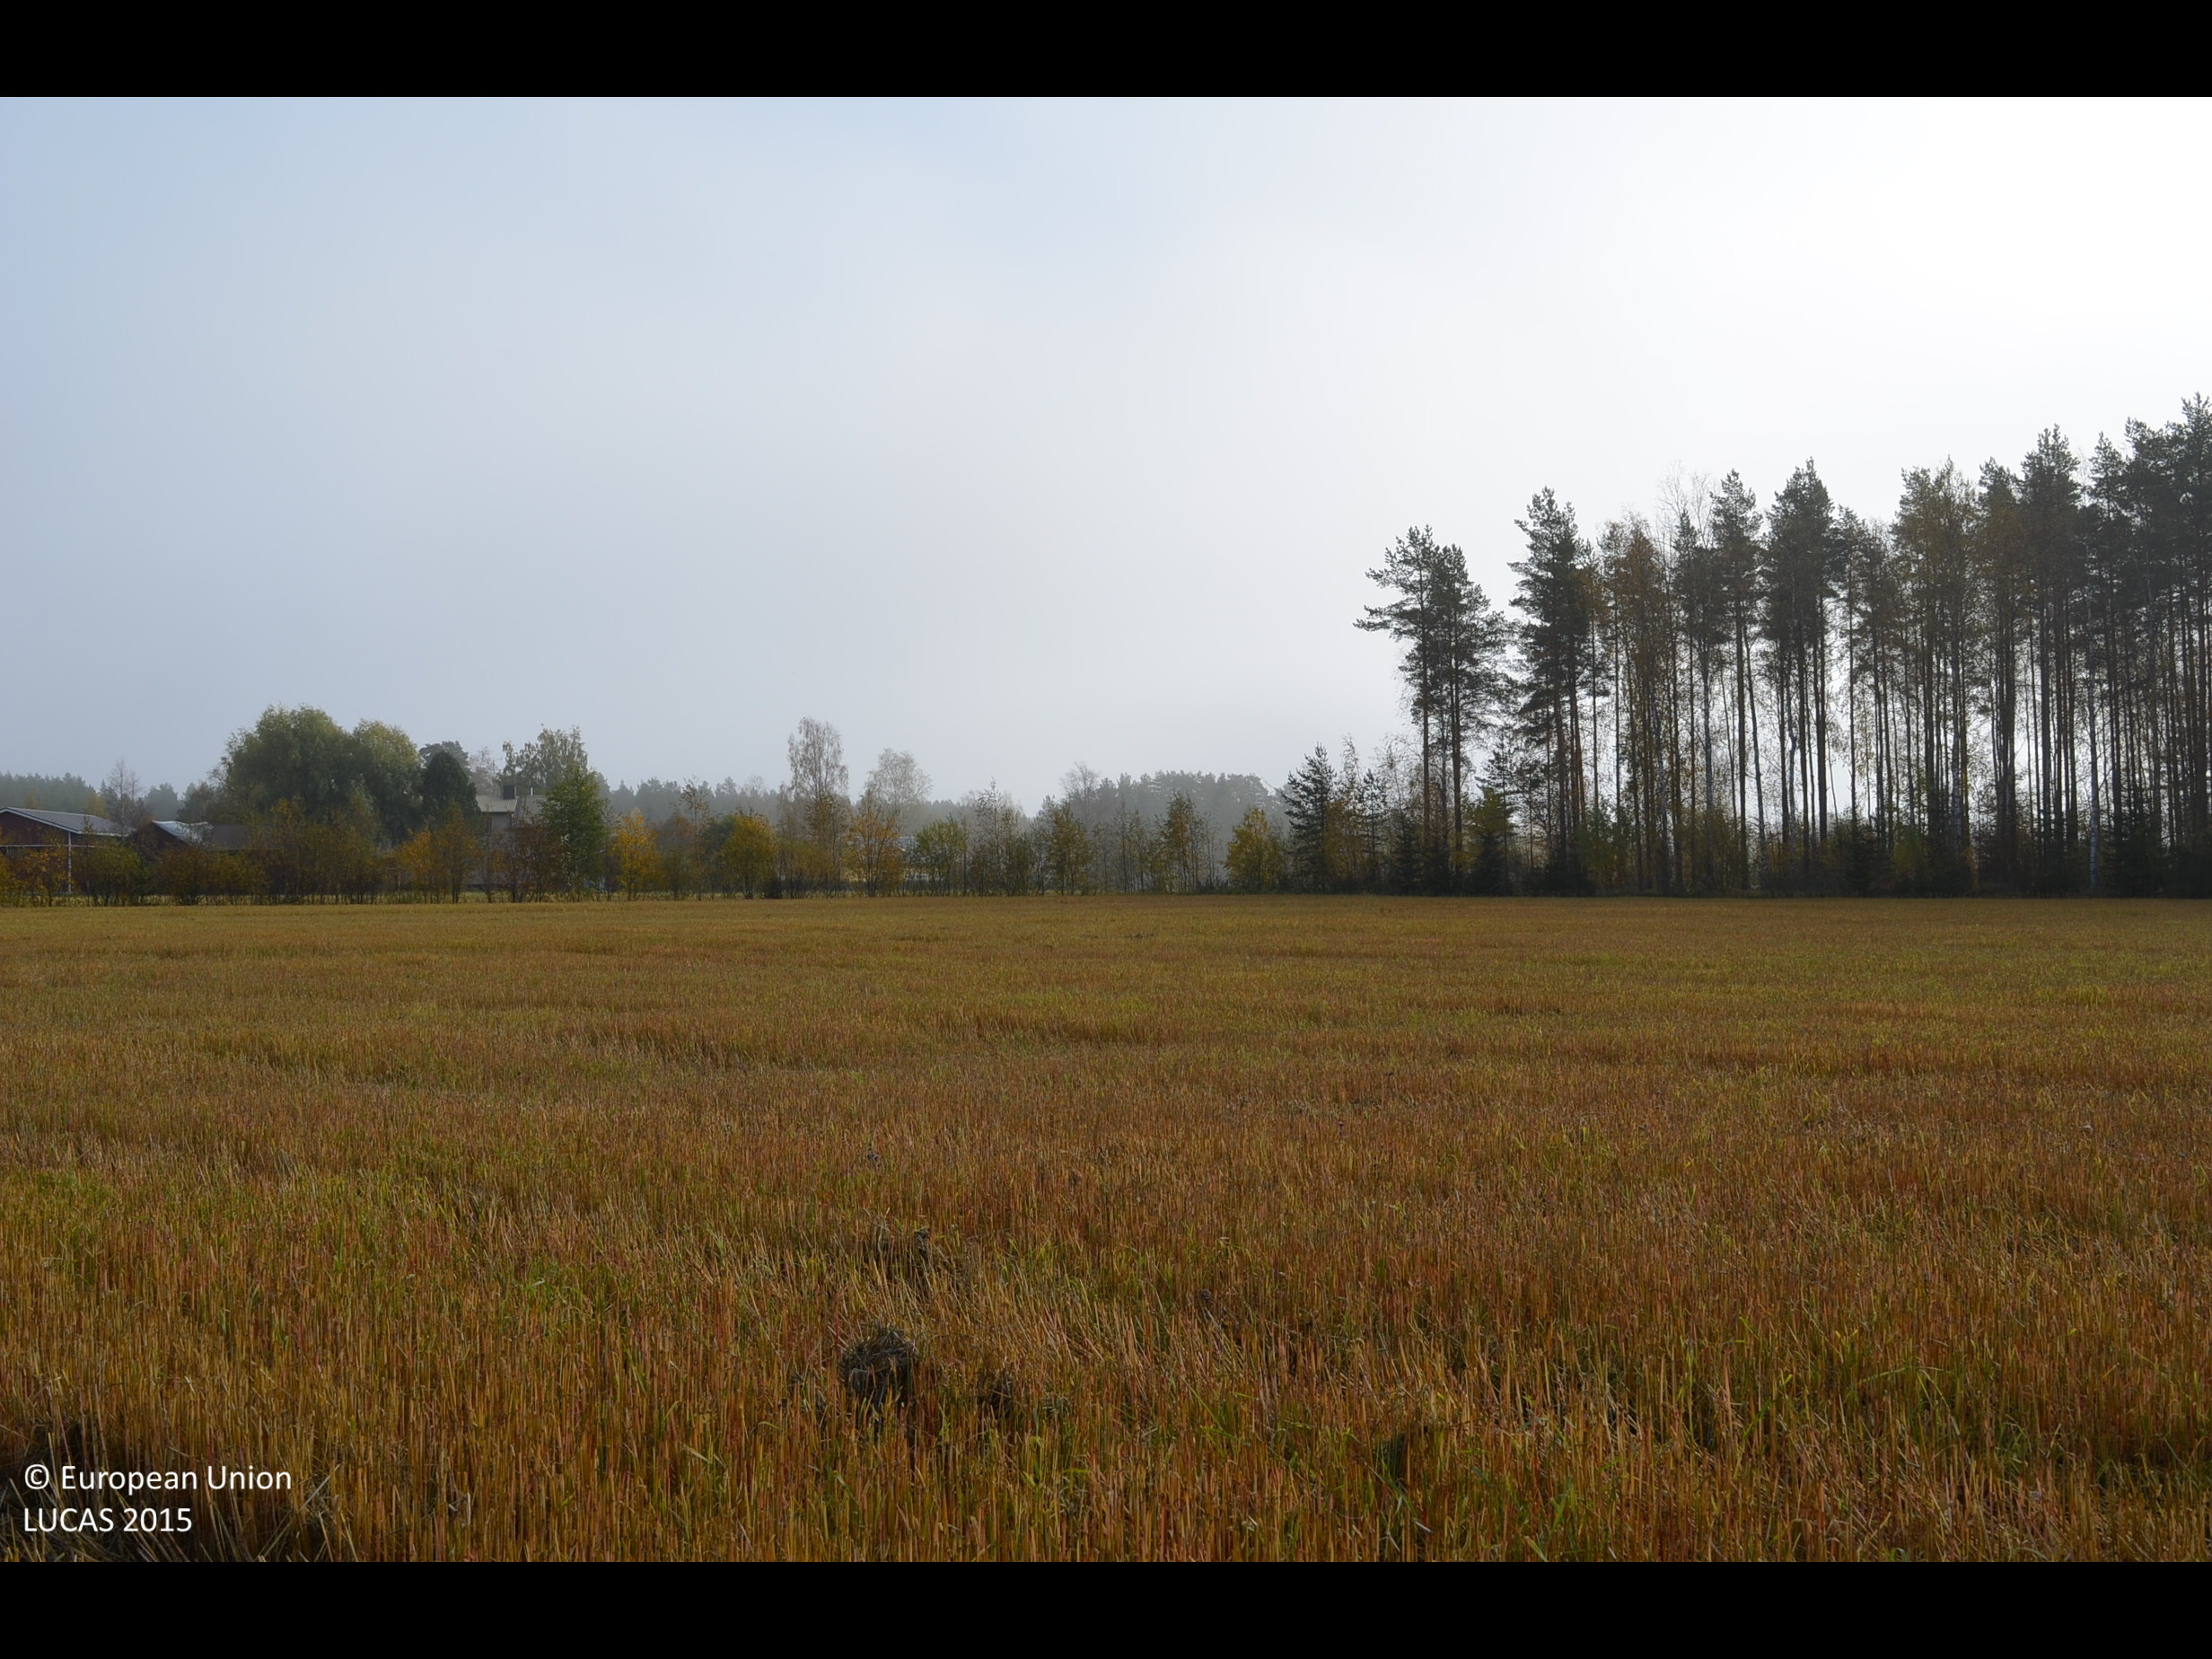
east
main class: Cropland
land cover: Oats
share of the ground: > 75 %
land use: Agriculture (excluding fallow land and kitchen gardens)
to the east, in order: Oats; Grass margins; Managed hedges; Ditches and canals; Grass margins; Oats; Artificial constructions in urban areas
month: September
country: FI
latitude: 62.5998
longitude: 23.5694
